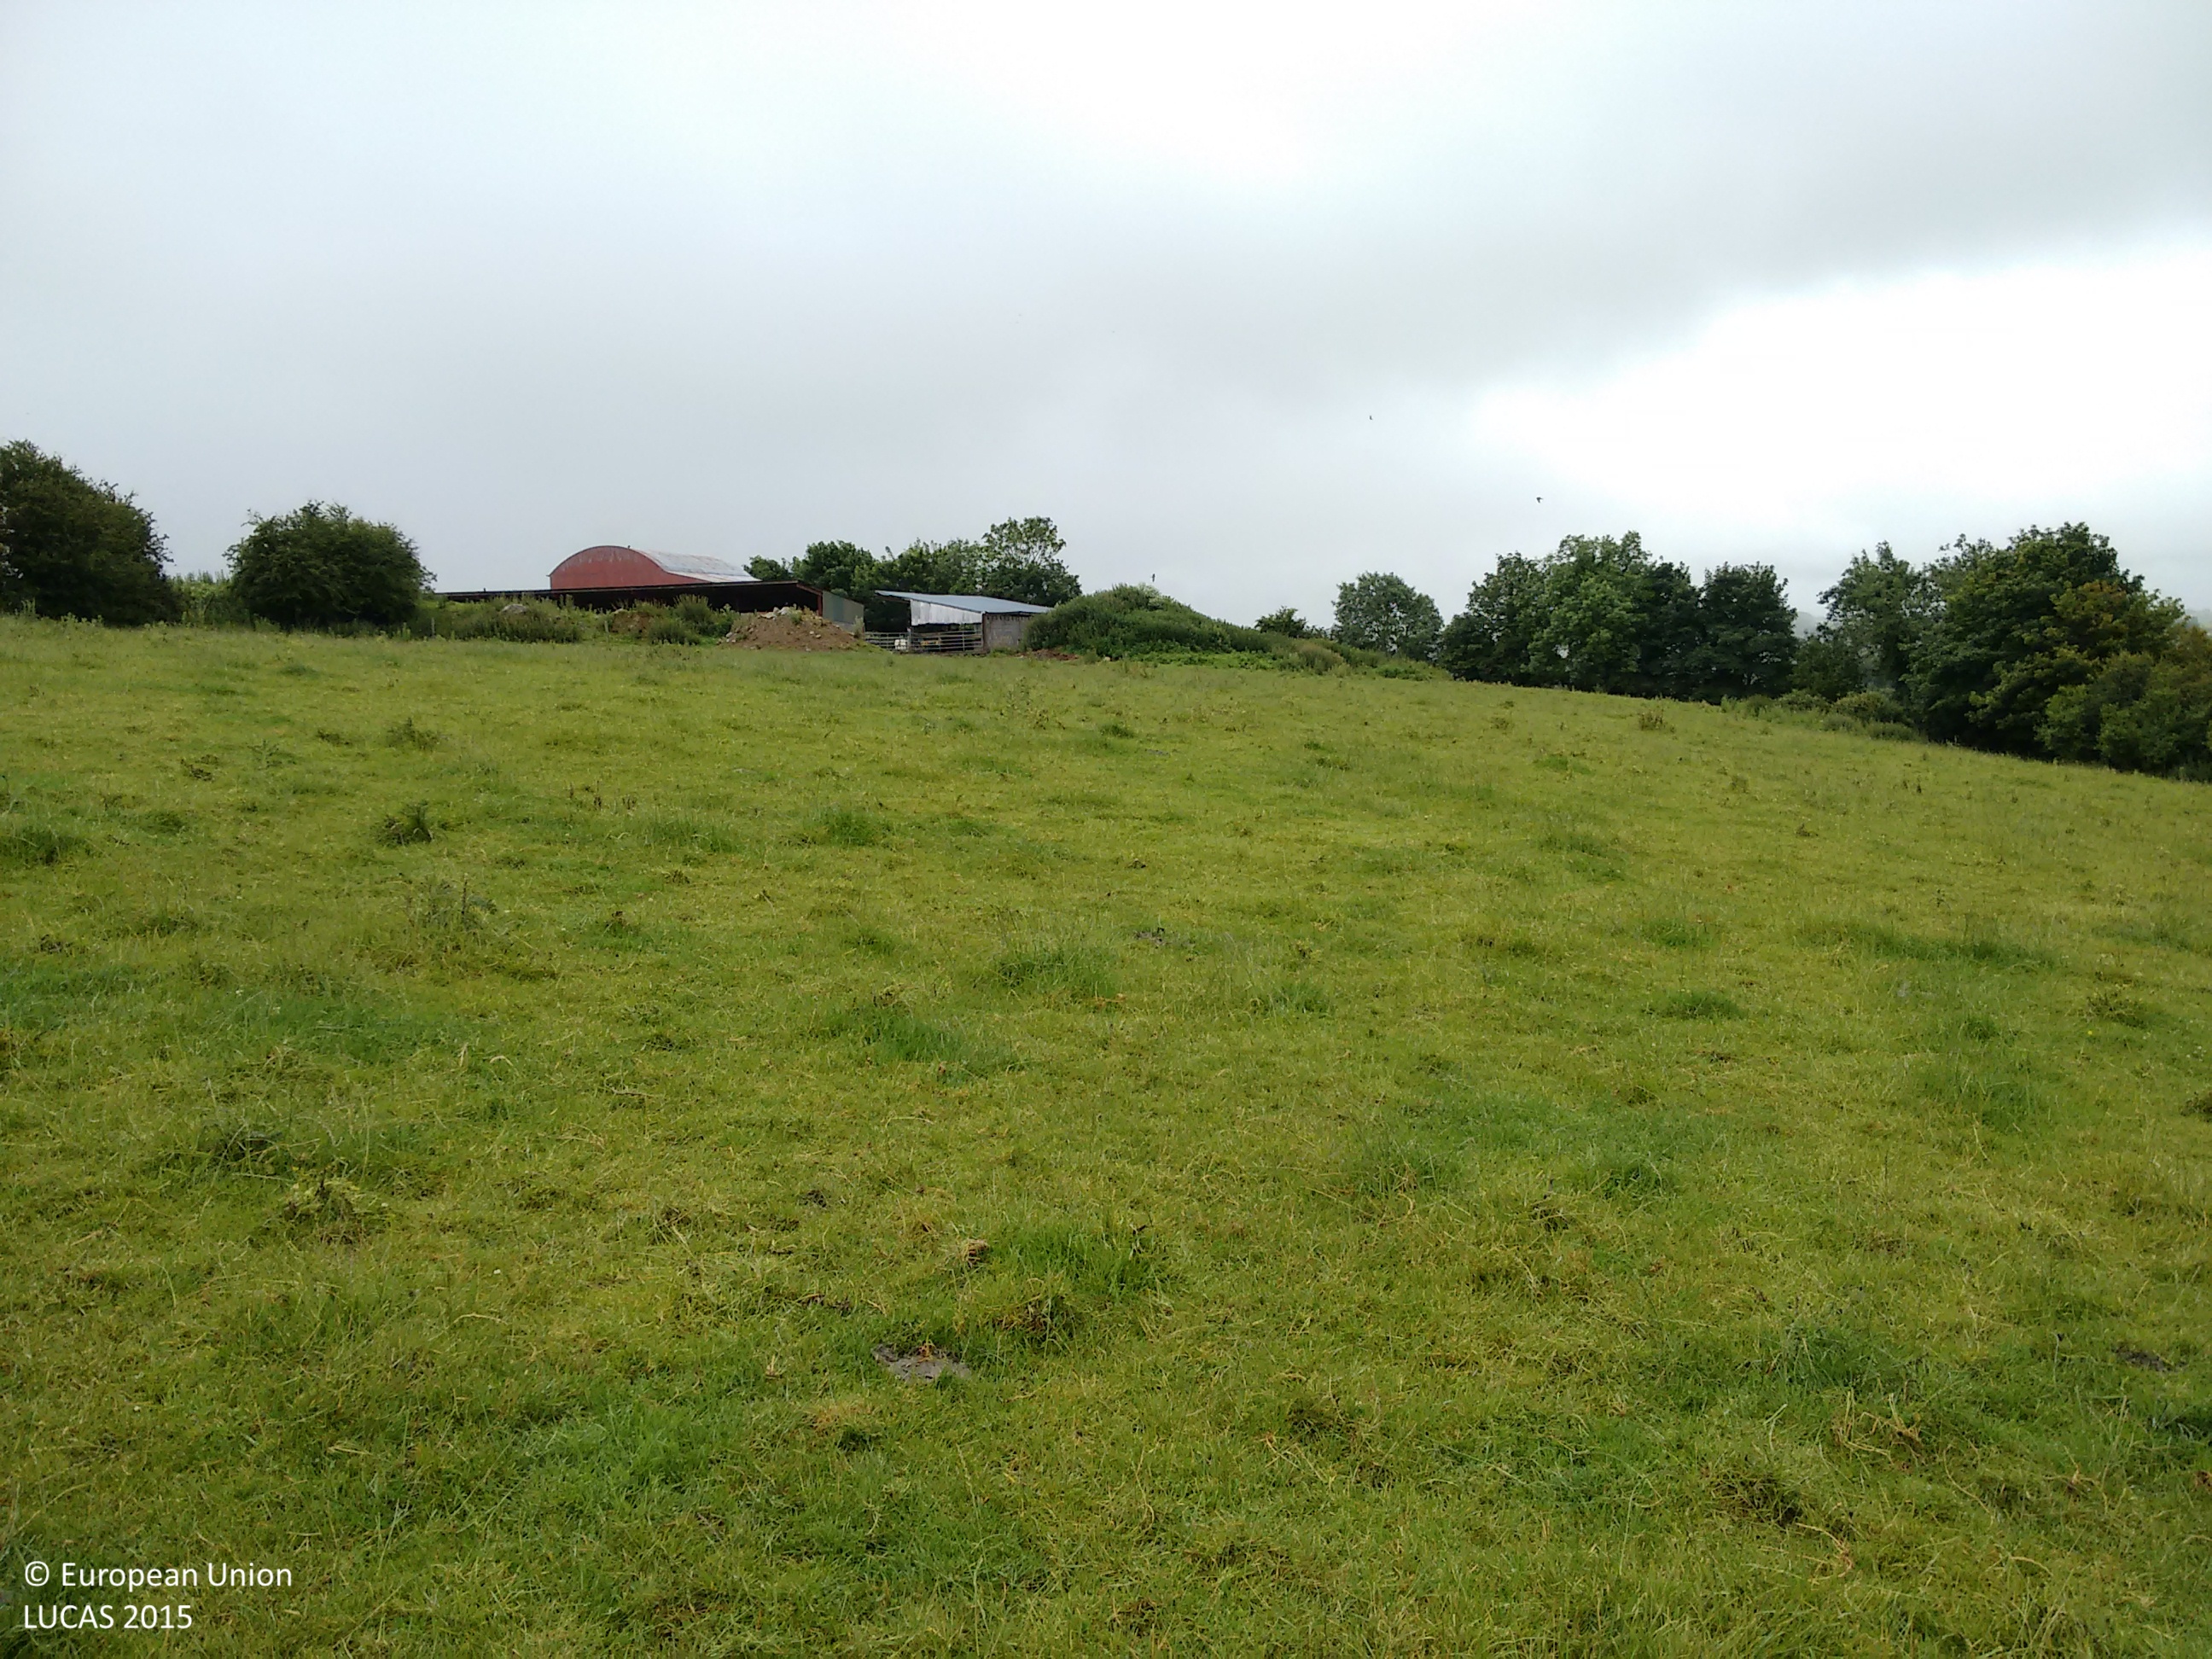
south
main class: Grassland
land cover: Grassland without tree/shrub cover
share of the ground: > 75 %
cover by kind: herbaceous plants 100 %
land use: Agriculture (excluding fallow land and kitchen gardens)
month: July
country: IE
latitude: 53.5024
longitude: -7.8233
